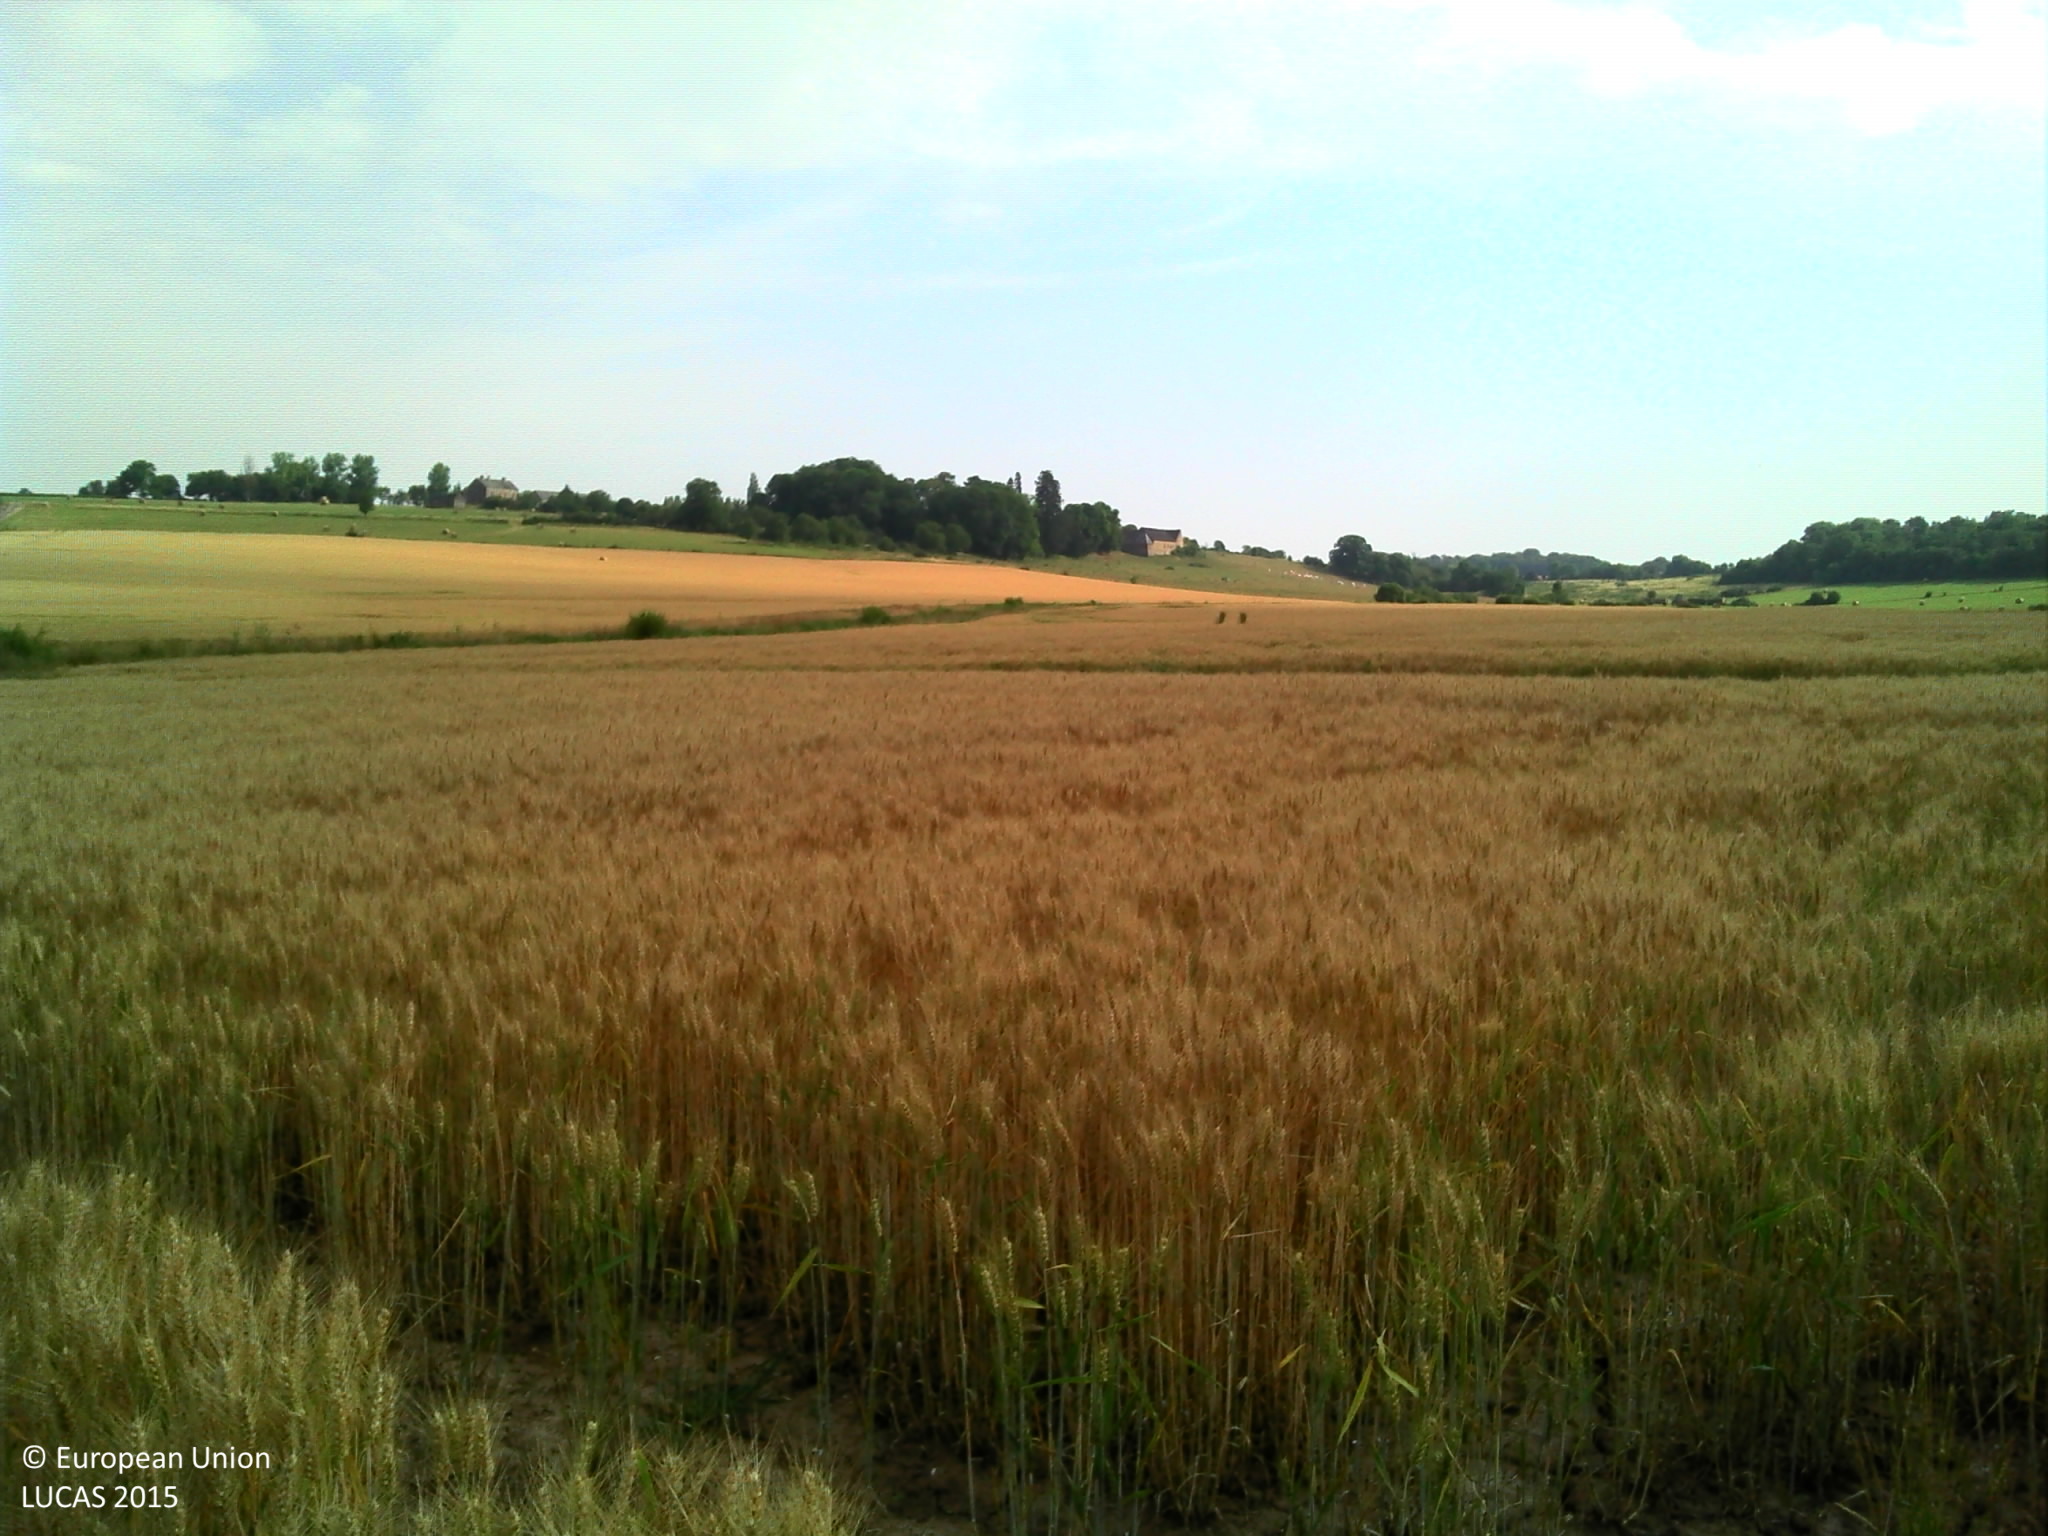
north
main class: Cropland
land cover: Common wheat
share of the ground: > 75 %
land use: Agriculture (excluding fallow land and kitchen gardens)
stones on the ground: < 10 %
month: July
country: FR
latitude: 47.0976
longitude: 3.5812
